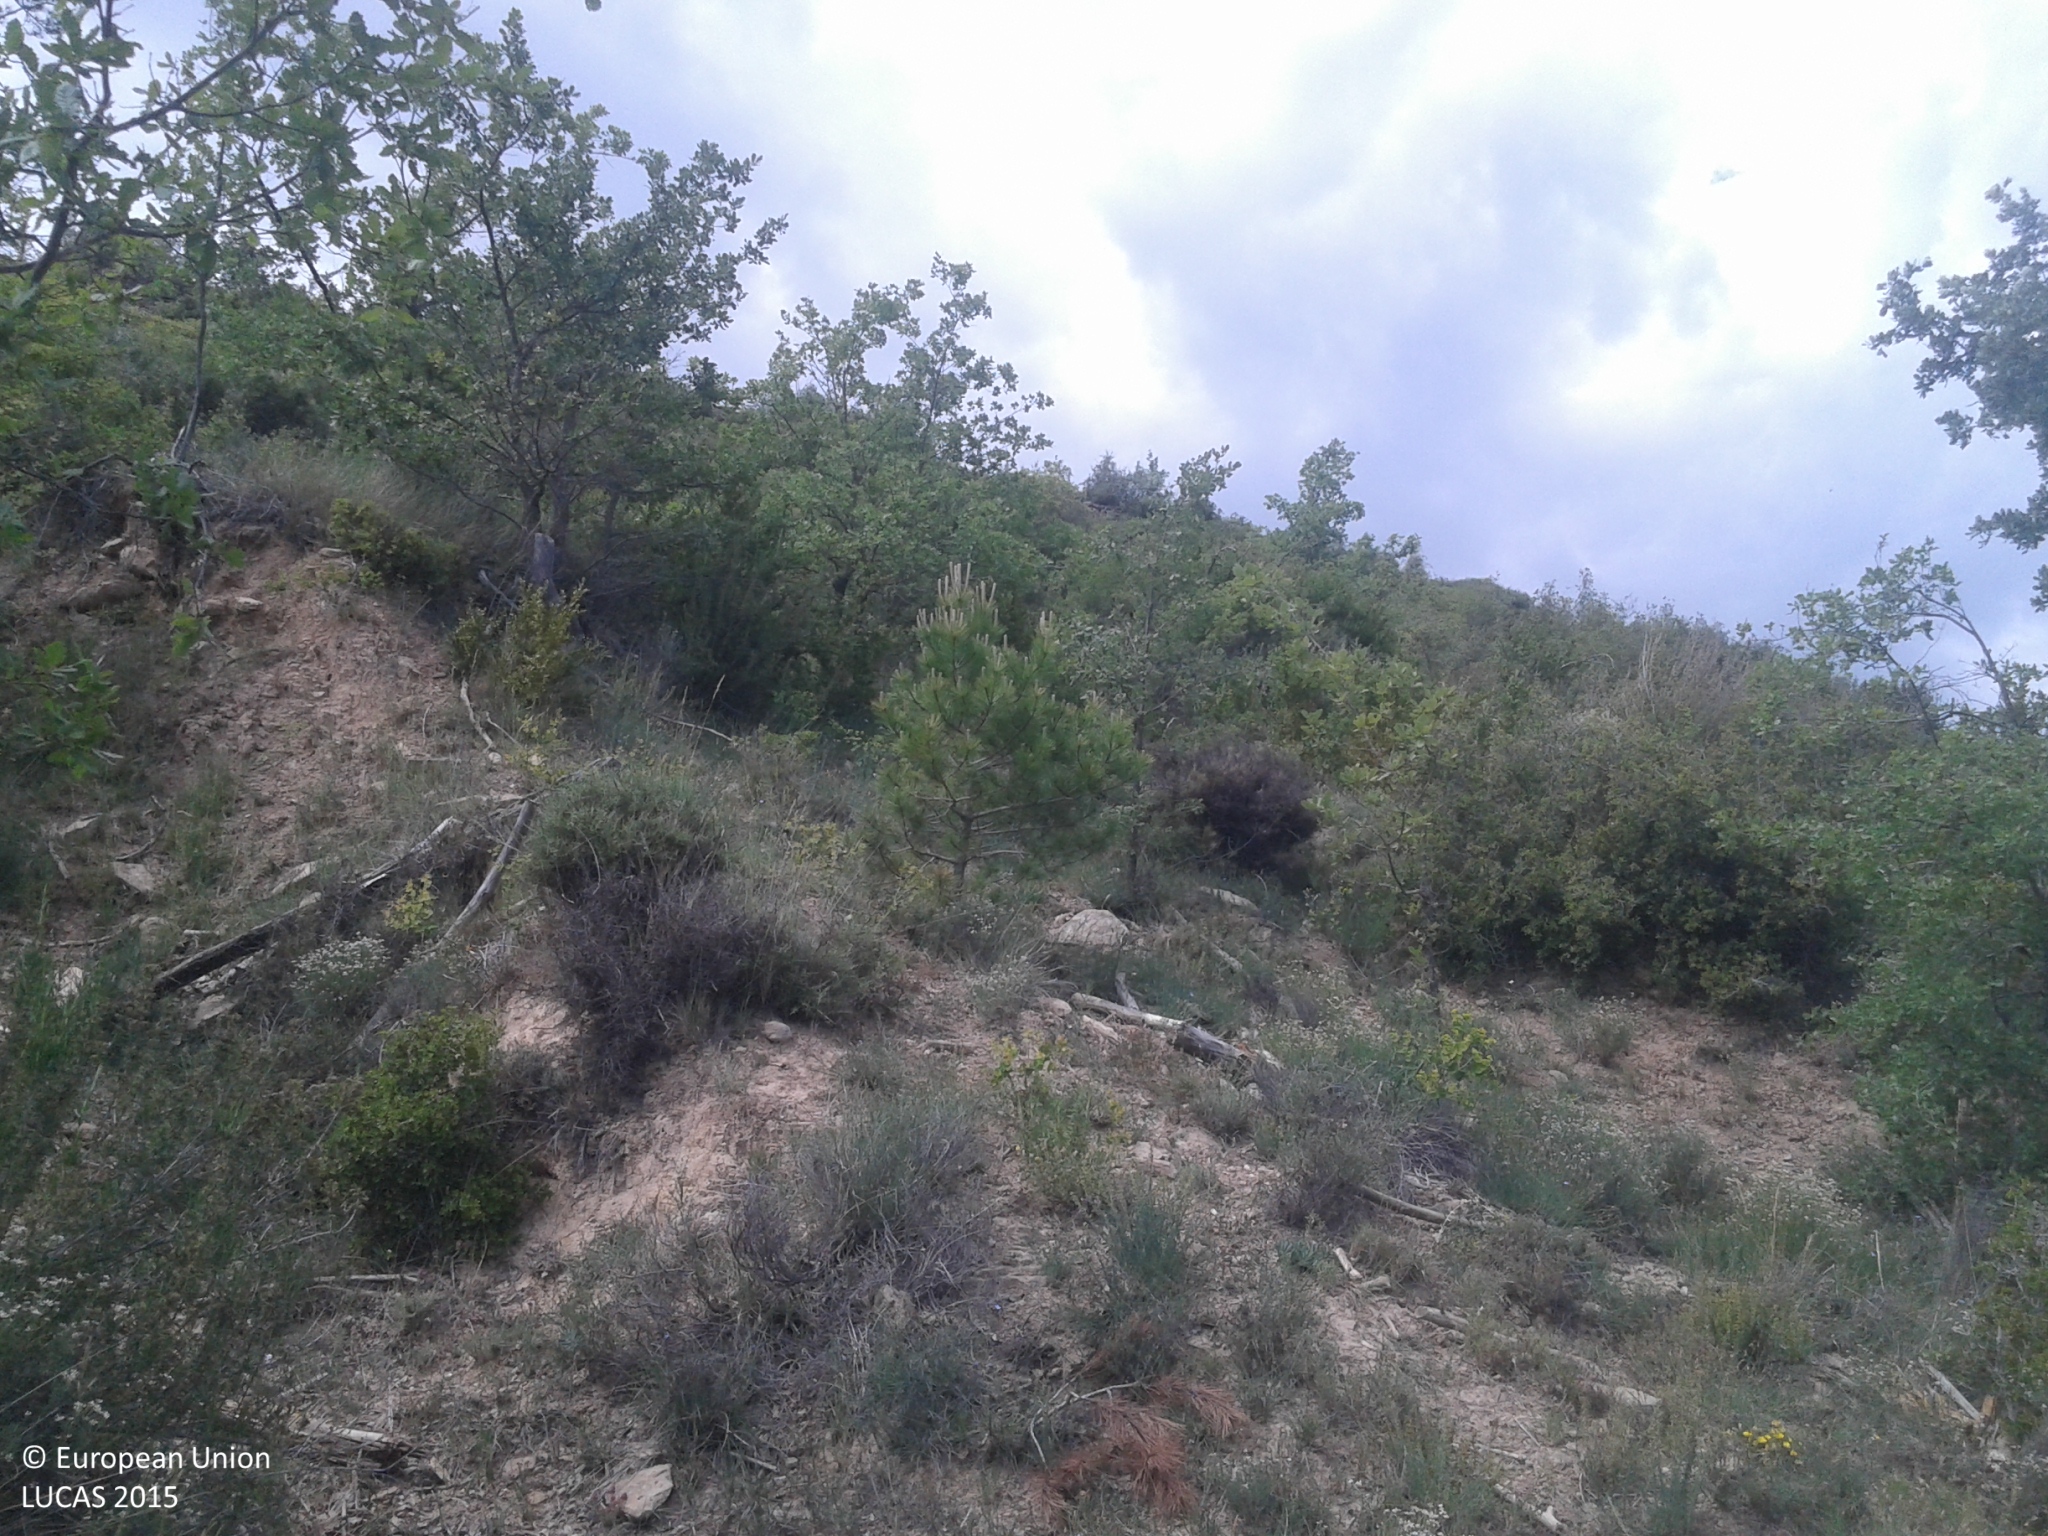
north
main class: Woodland
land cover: Broadleaved woodland
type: thermophilous deciduous forest
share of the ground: 10 - 25 %
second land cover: Shrubland without tree cover
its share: 25 - 50 %
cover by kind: shrubs 75 %, broadleaved forest trees 15 %, herbaceous plants 10 %
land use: Forestry
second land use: Agriculture (excluding fallow land and kitchen gardens)
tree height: < 5 m
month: May
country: ES
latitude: 41.9042
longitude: 1.5871
